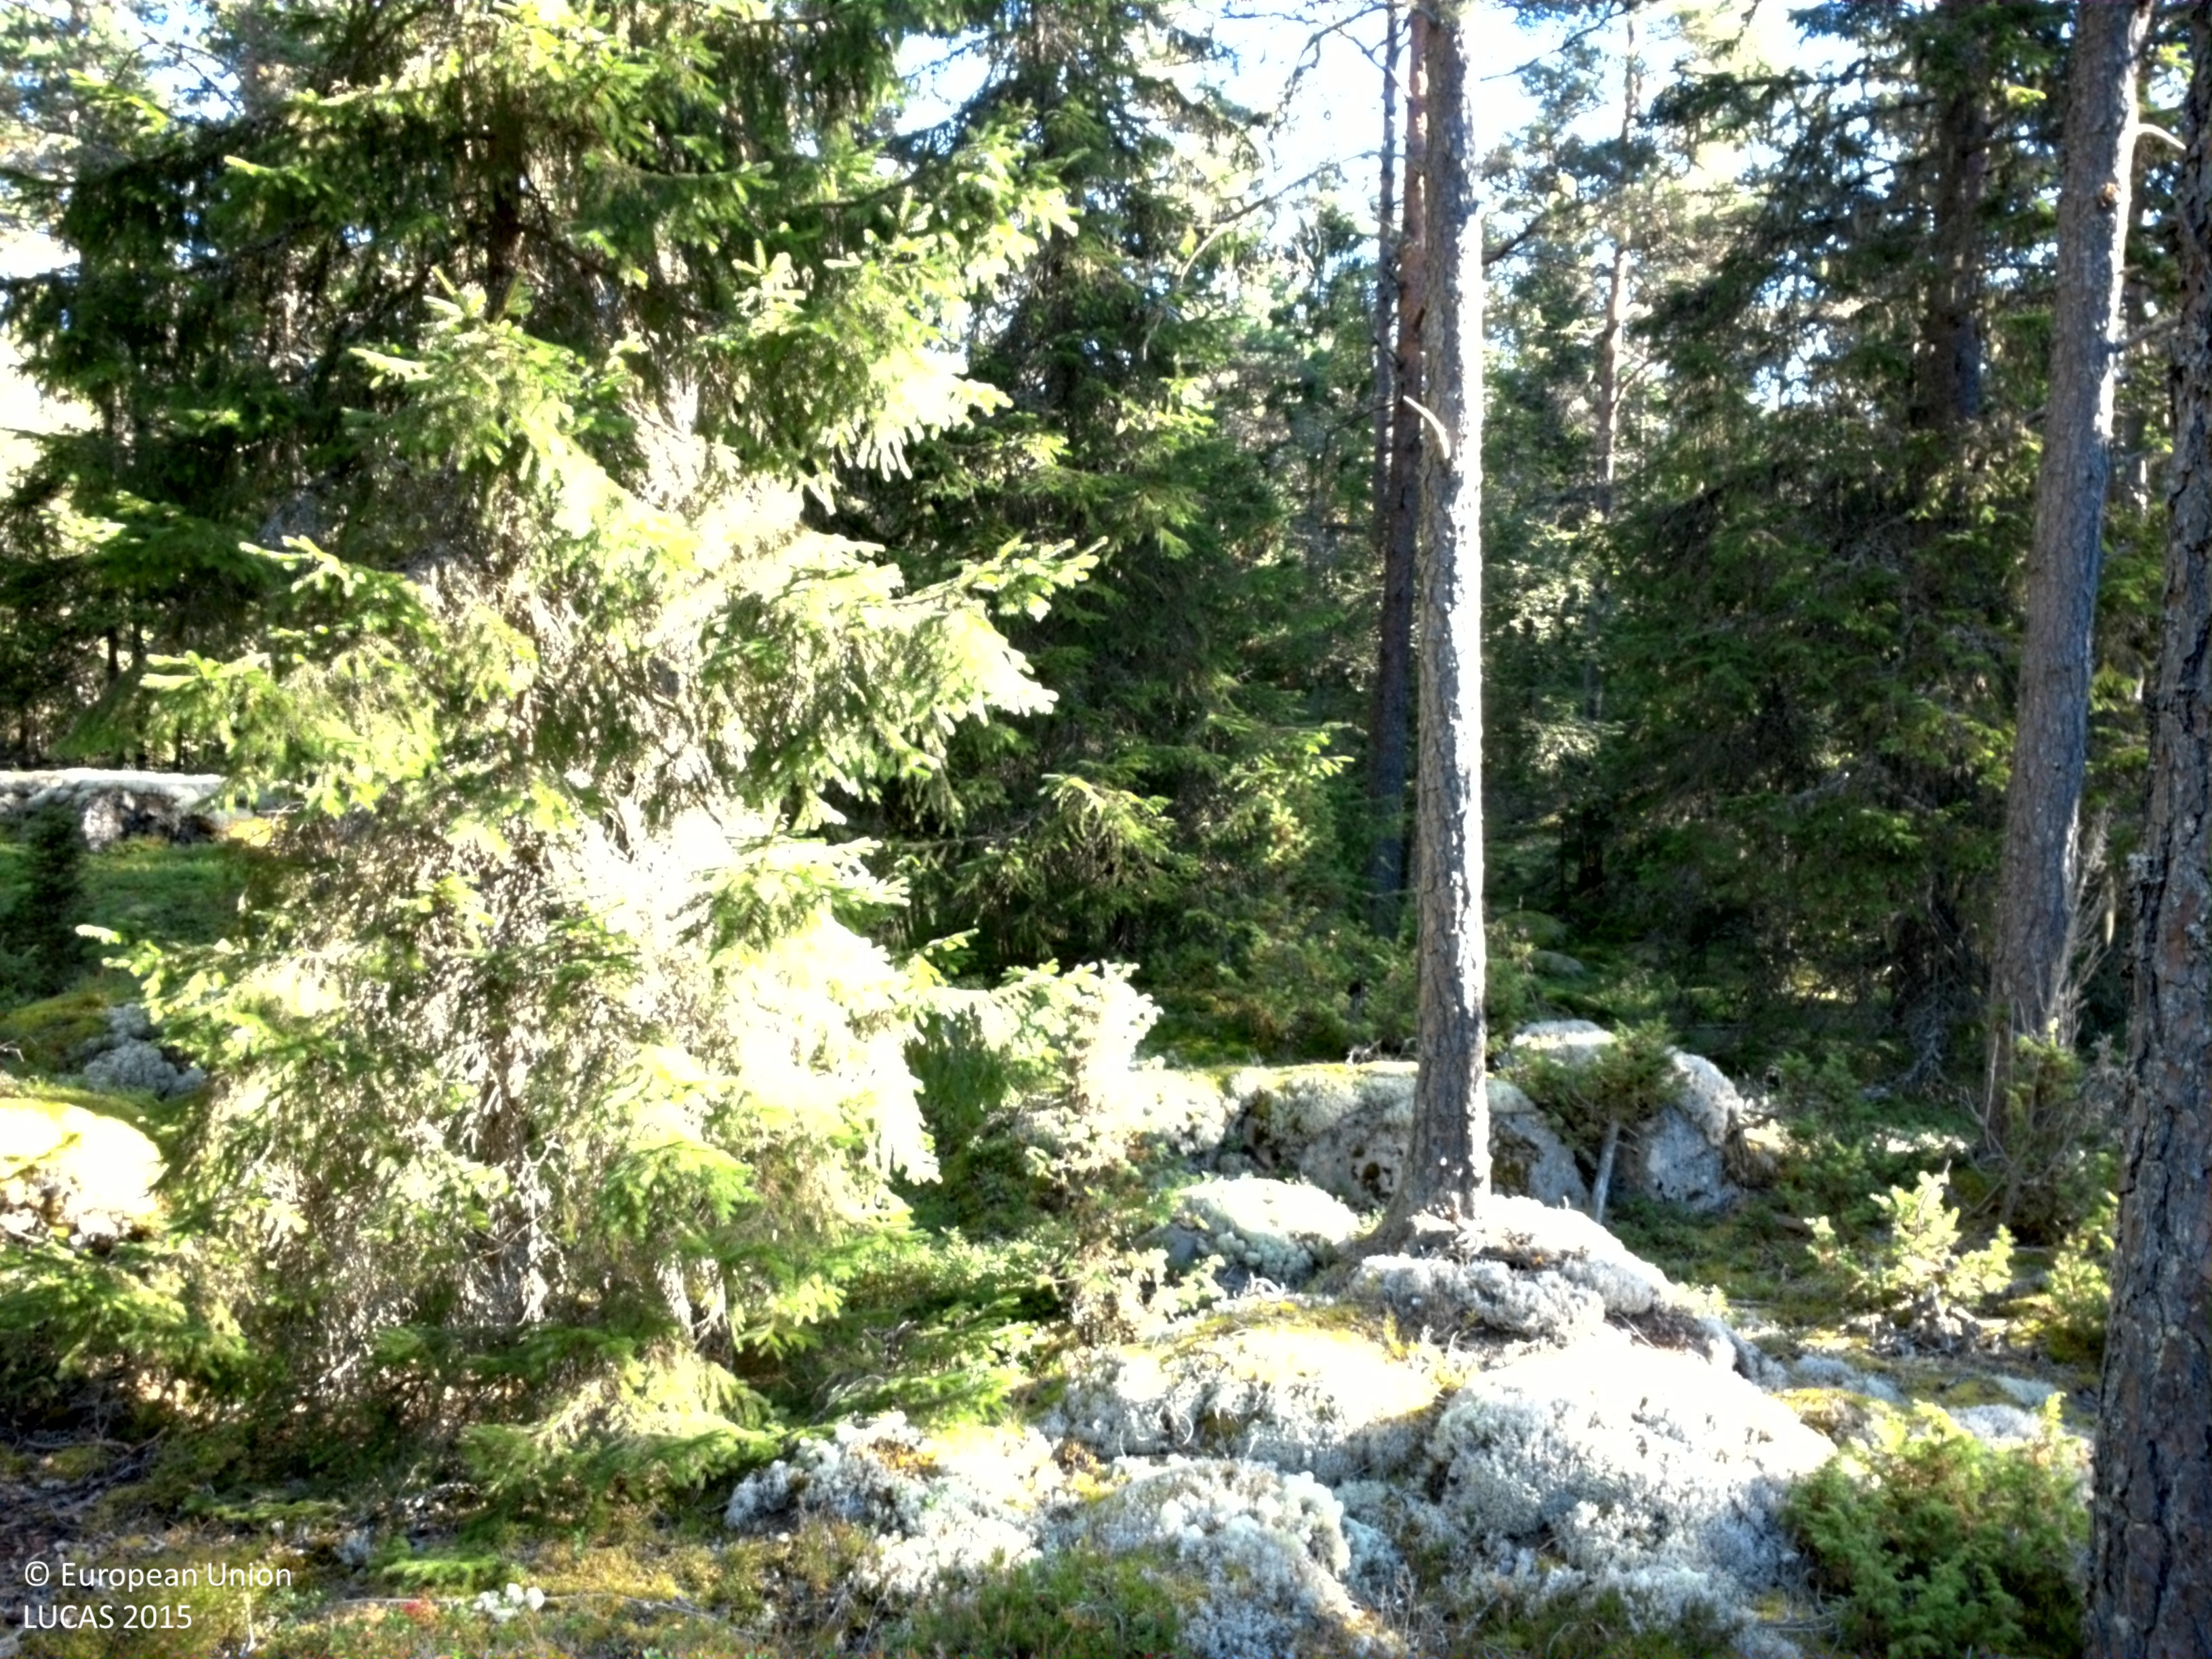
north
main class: Woodland
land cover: Pine dominated coniferous woodland
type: boreal forest
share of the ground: 50 - 75 %
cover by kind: coniferous forest trees 65 %, lichens and mosses 25 %, shrubs 10 %
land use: Forestry
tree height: > 5 m
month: August
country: SE
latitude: 59.7775
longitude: 17.2423
